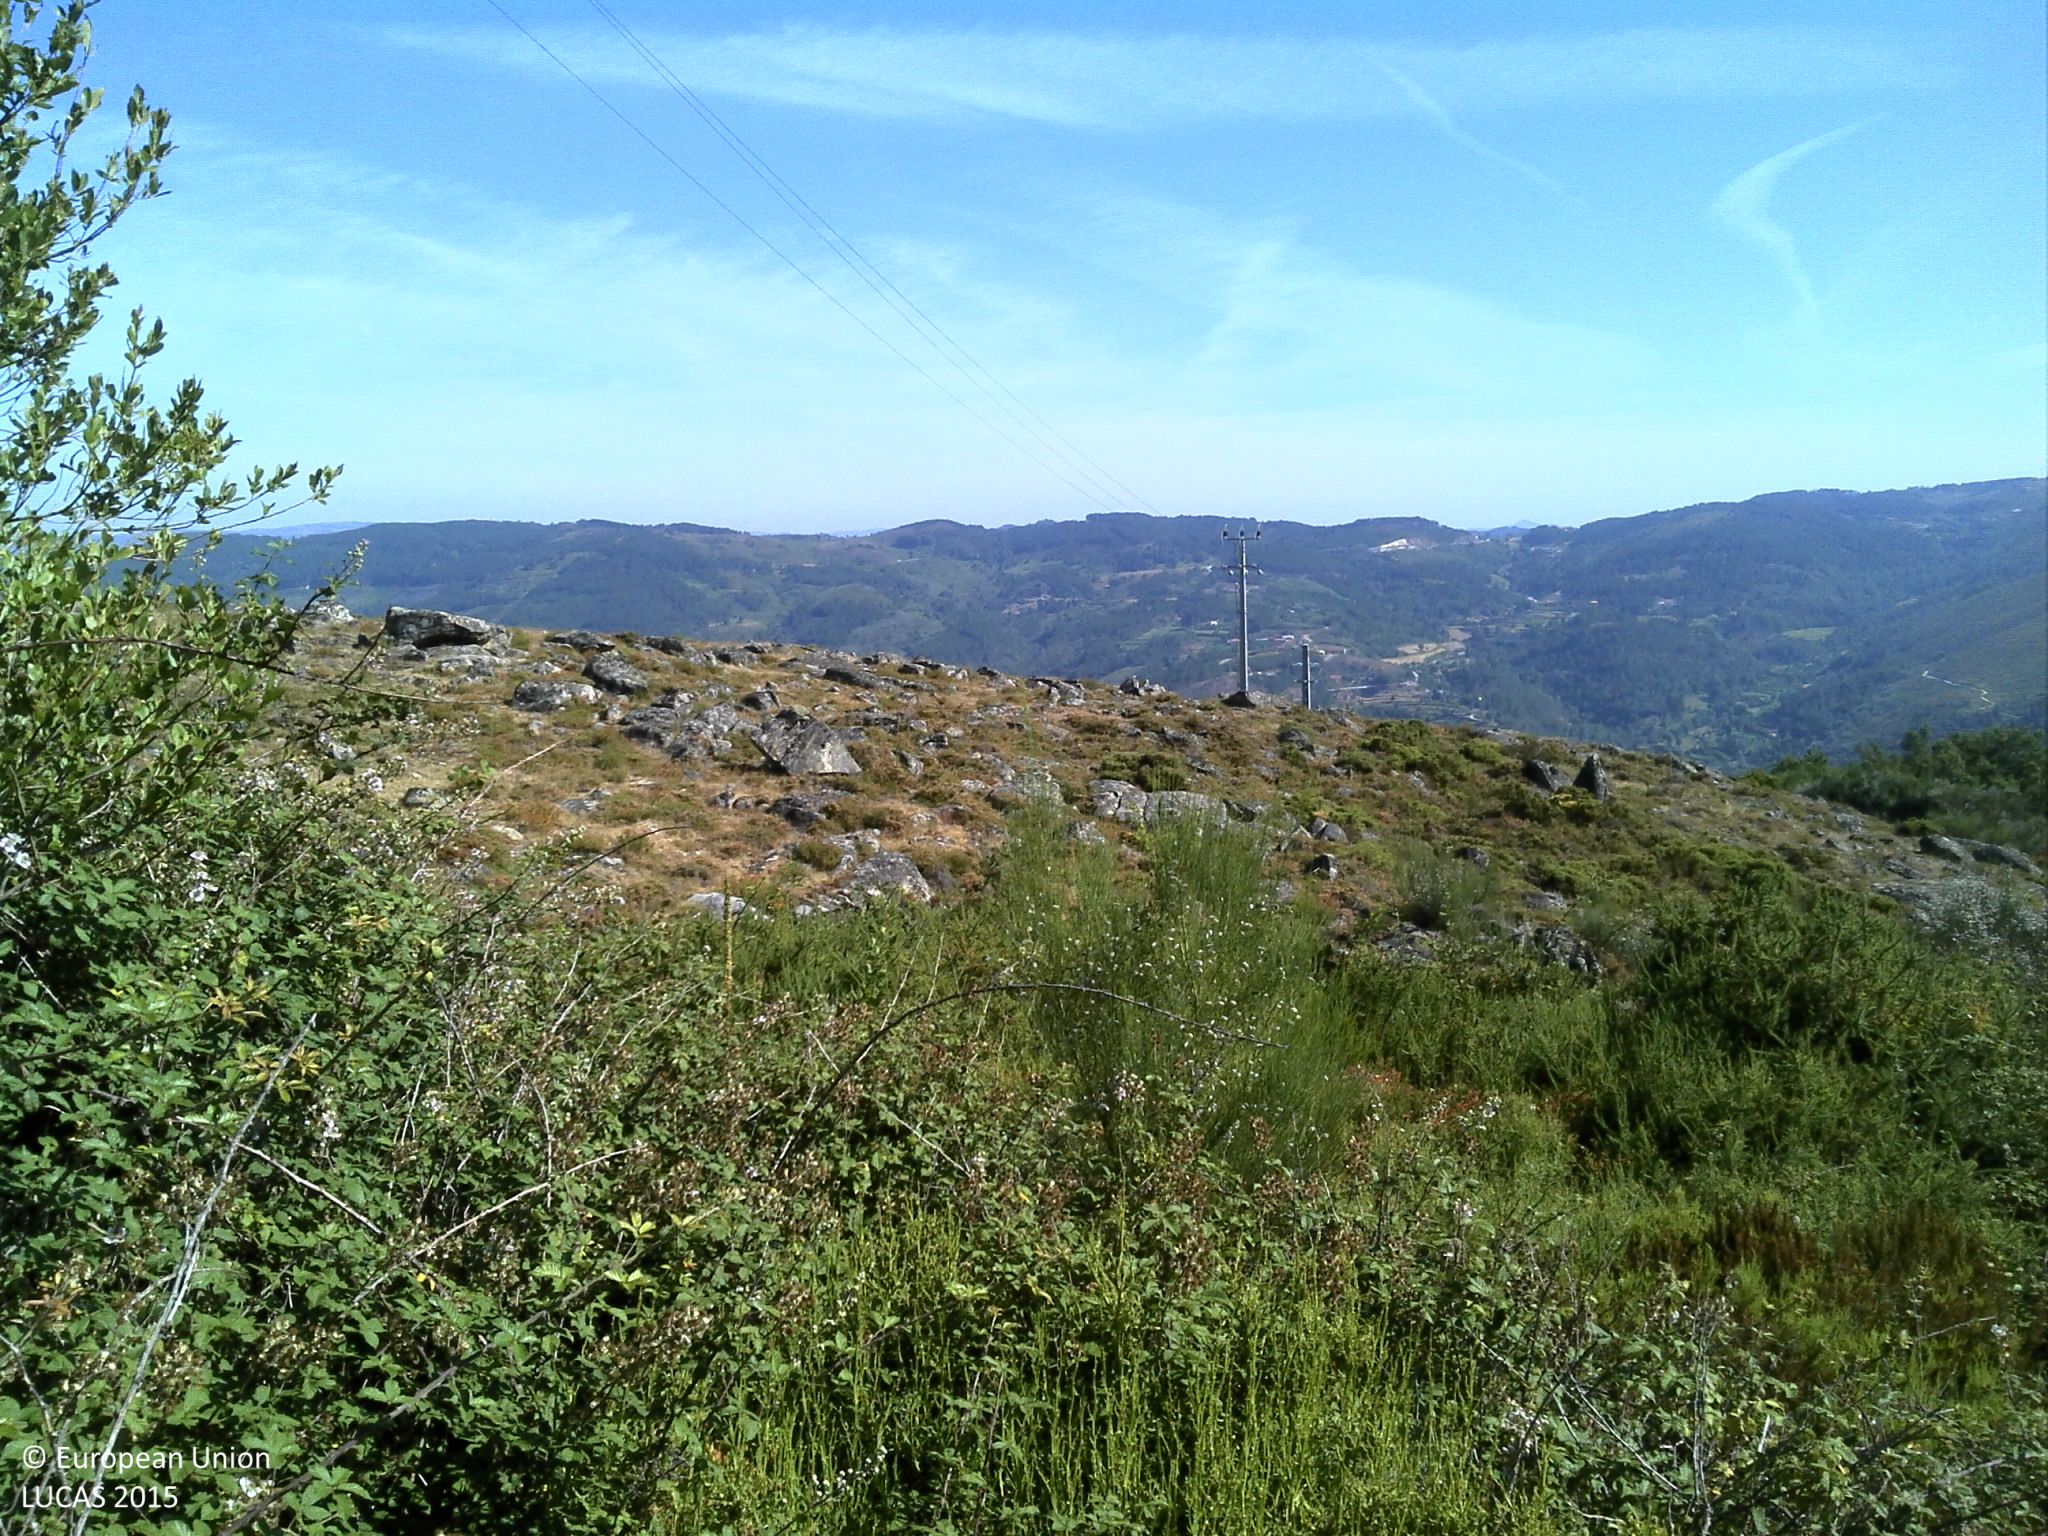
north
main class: Shrubland
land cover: Shrubland without tree cover
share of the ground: > 75 %
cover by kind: shrubs 90 %, consolidated bare surface 5 %, unconsolidated bare surface 5 %
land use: Agriculture (excluding fallow land and kitchen gardens)
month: July
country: PT
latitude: 41.4472
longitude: -7.8141
